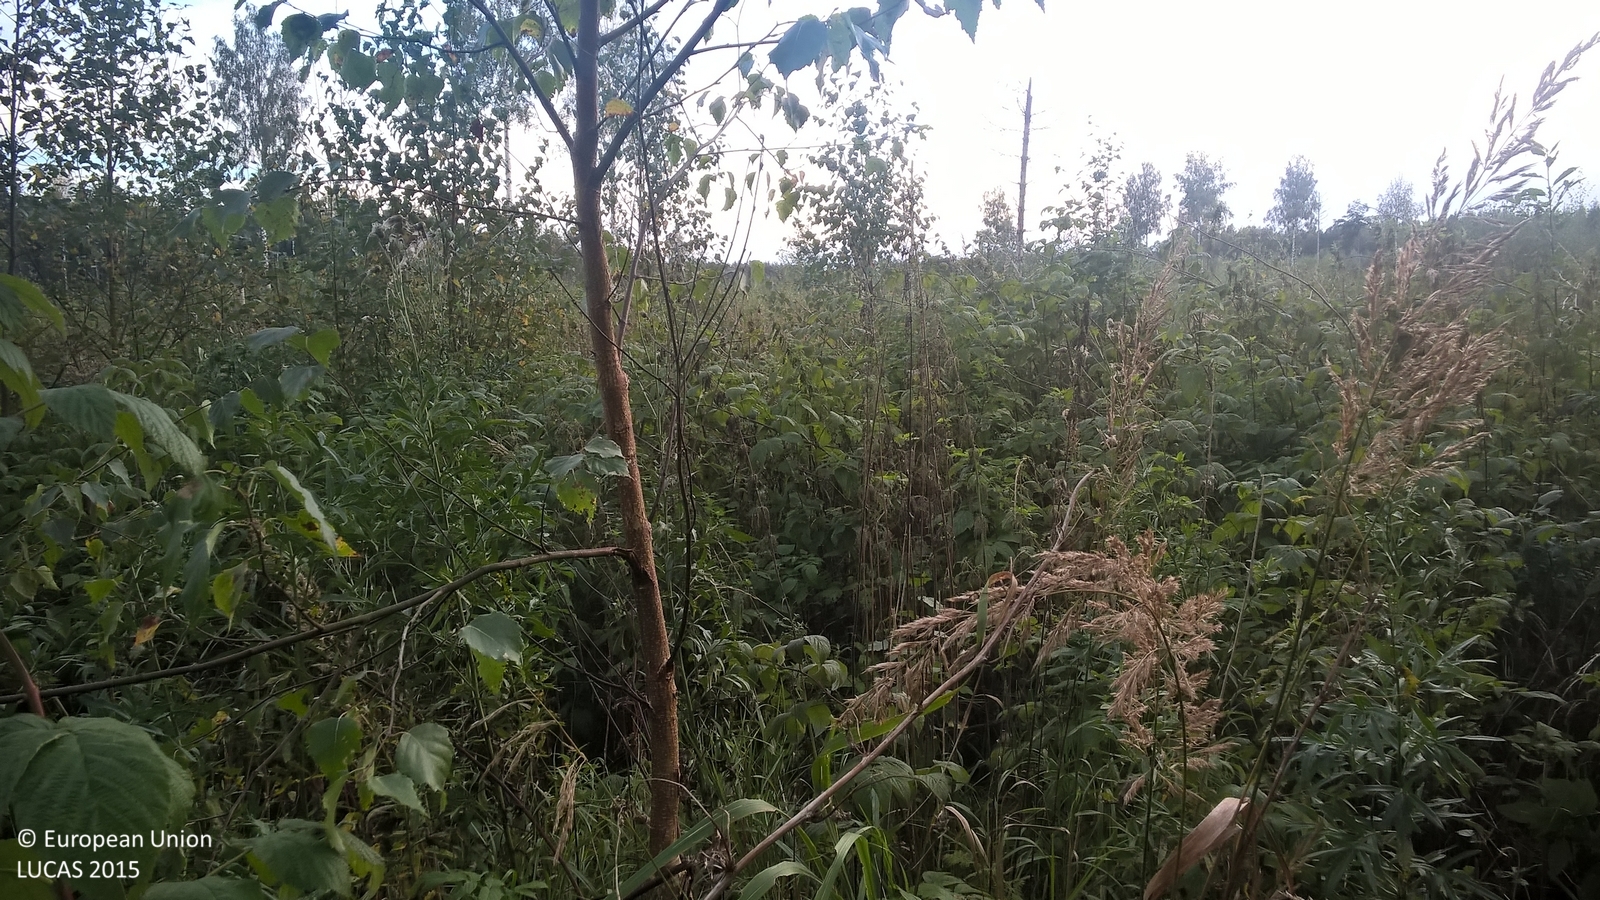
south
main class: Shrubland
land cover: Shrubland with sparse tree cover
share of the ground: > 75 %
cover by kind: shrubs 95 %, broadleaved forest trees 5 %
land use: Forestry
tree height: < 5 m
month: September
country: LV
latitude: 57.8396
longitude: 25.6989
